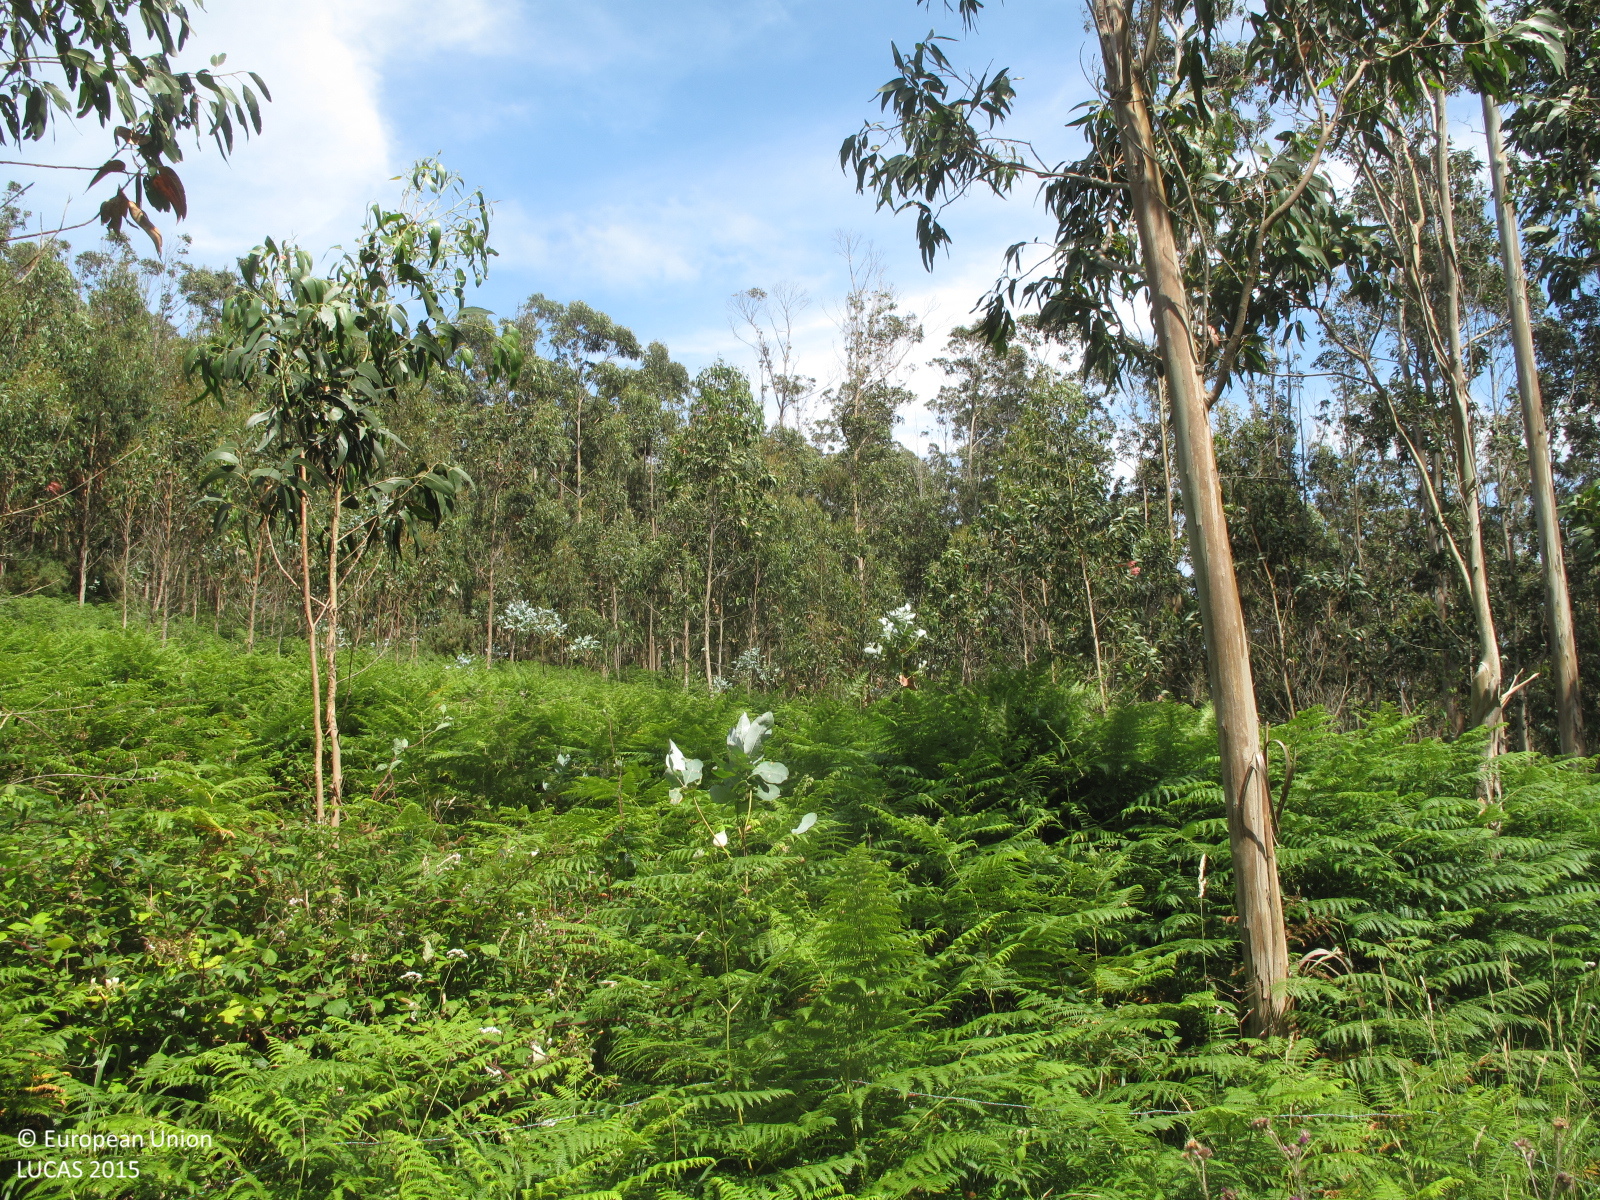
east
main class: Woodland
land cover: Broadleaved woodland
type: exotic forest
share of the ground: 50 - 75 %
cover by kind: broadleaved forest trees 50 %, herbaceous plants 30 %, shrubs 20 %
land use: Forestry
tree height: > 5 m
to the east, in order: Broadleaved woodland
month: July
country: ES
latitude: 43.6483
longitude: -8.0899
